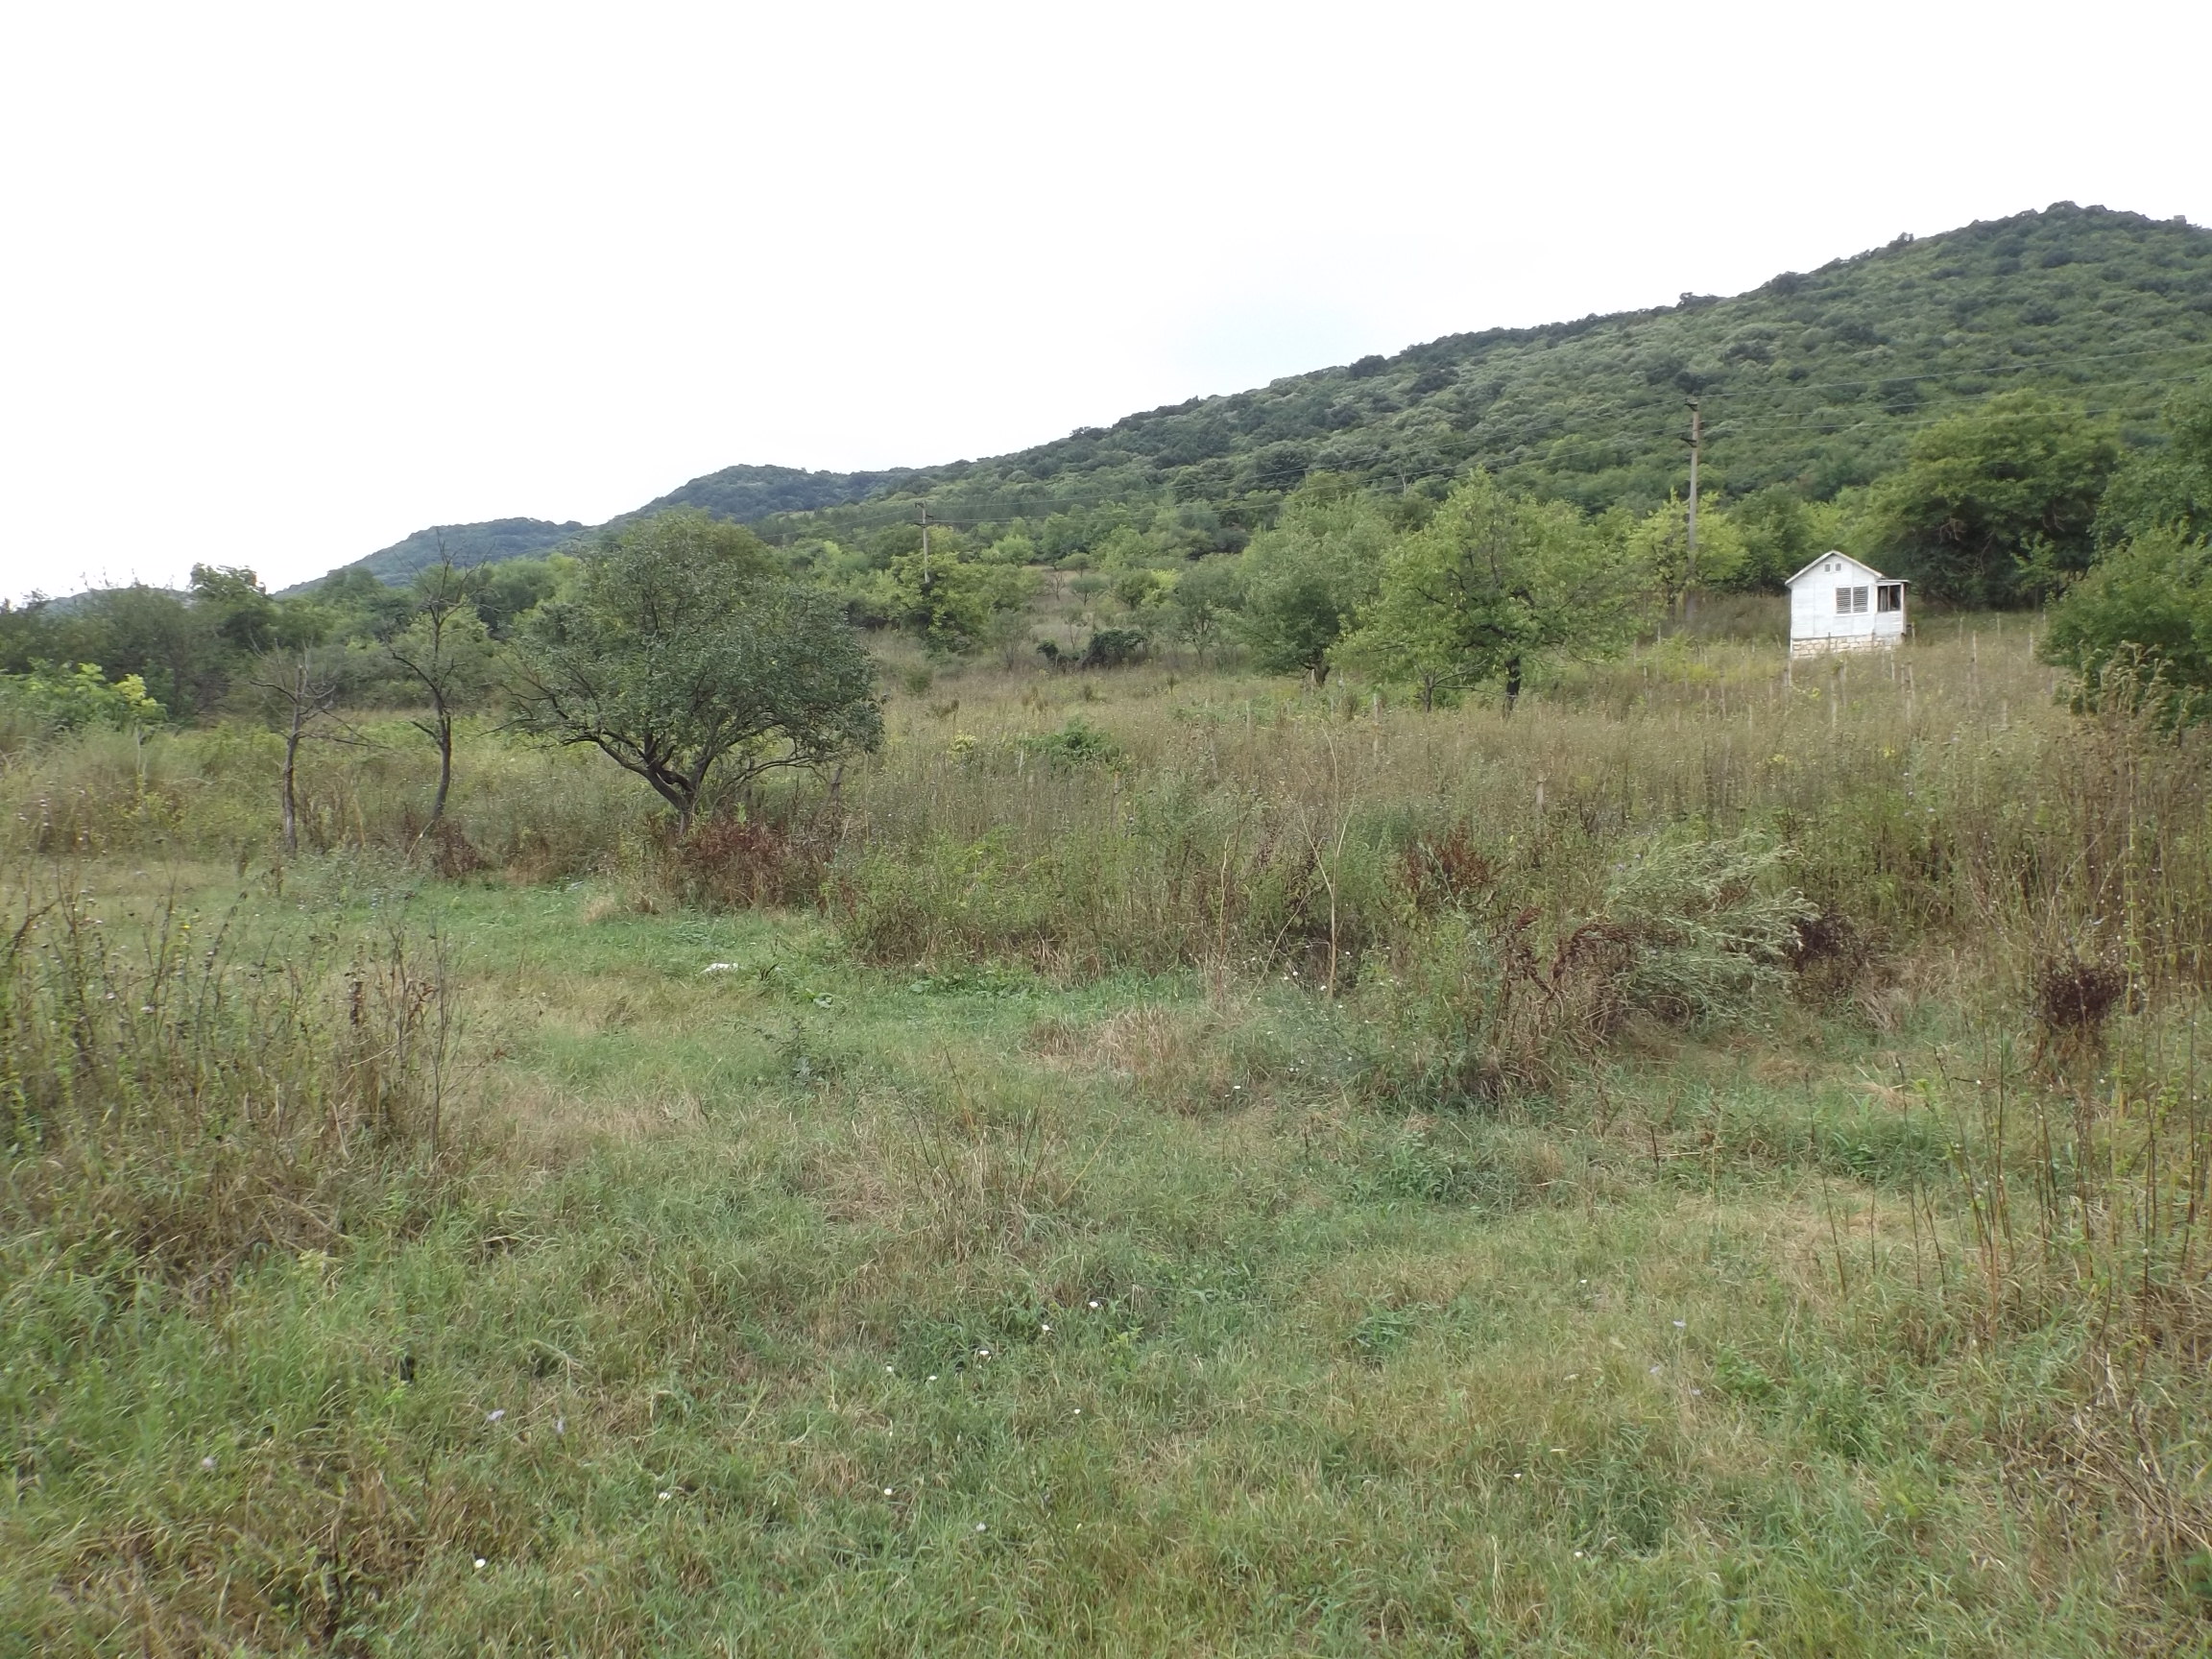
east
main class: Cropland
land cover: Cherry fruit
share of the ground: 10 - 25 %
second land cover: Grassland without tree/shrub cover
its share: > 75 %
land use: Abandoned areas
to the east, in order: Cherry fruit; Grassland without tree/shrub cover; Tracks; Spontaneously vegetated surfaces; Vineyards; Spontaneously vegetated surfaces; Nuts trees; Electric lines; Spontaneously vegetated surfaces; Tracks; Nuts trees
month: August
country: BG
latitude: 43.2090
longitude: 27.4439
